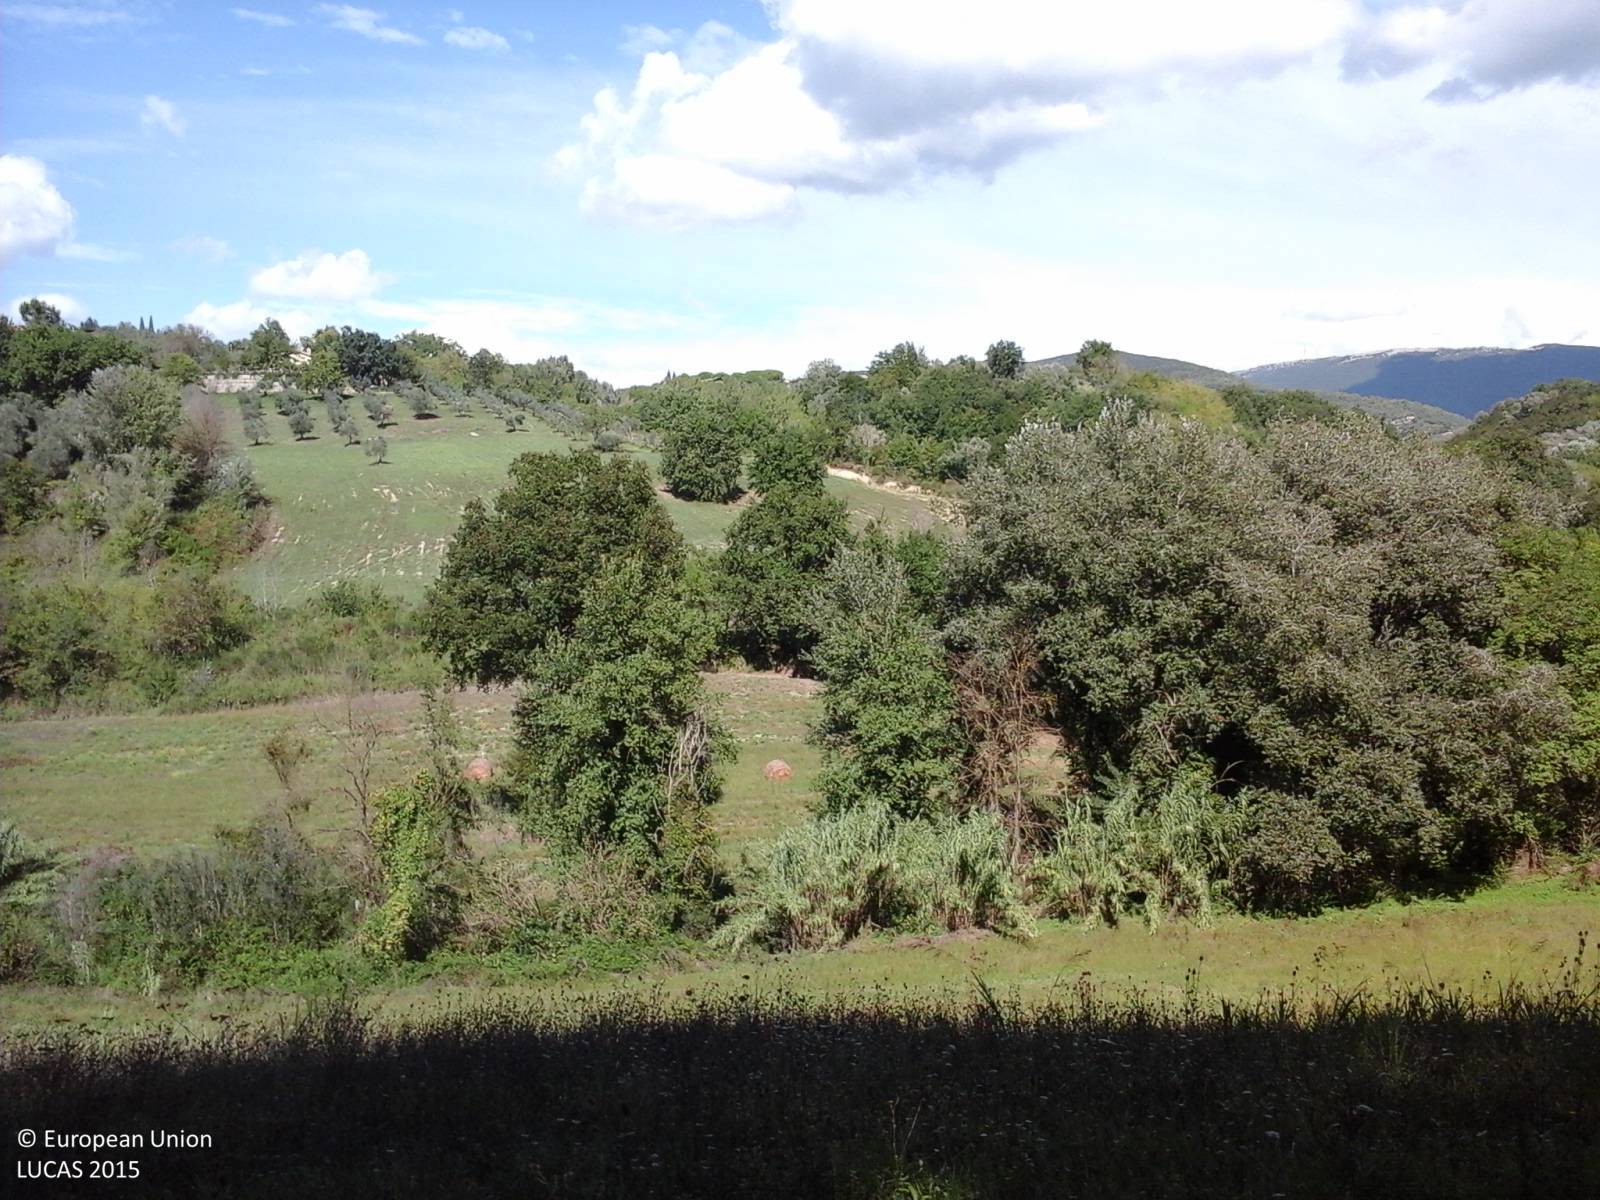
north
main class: Woodland
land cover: Broadleaved woodland
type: thermophilous deciduous forest
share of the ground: > 75 %
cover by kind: broadleaved forest trees 100 %
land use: Semi-natural and natural areas not in use
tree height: > 5 m
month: September
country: IT
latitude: 42.3502
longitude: 12.5770
